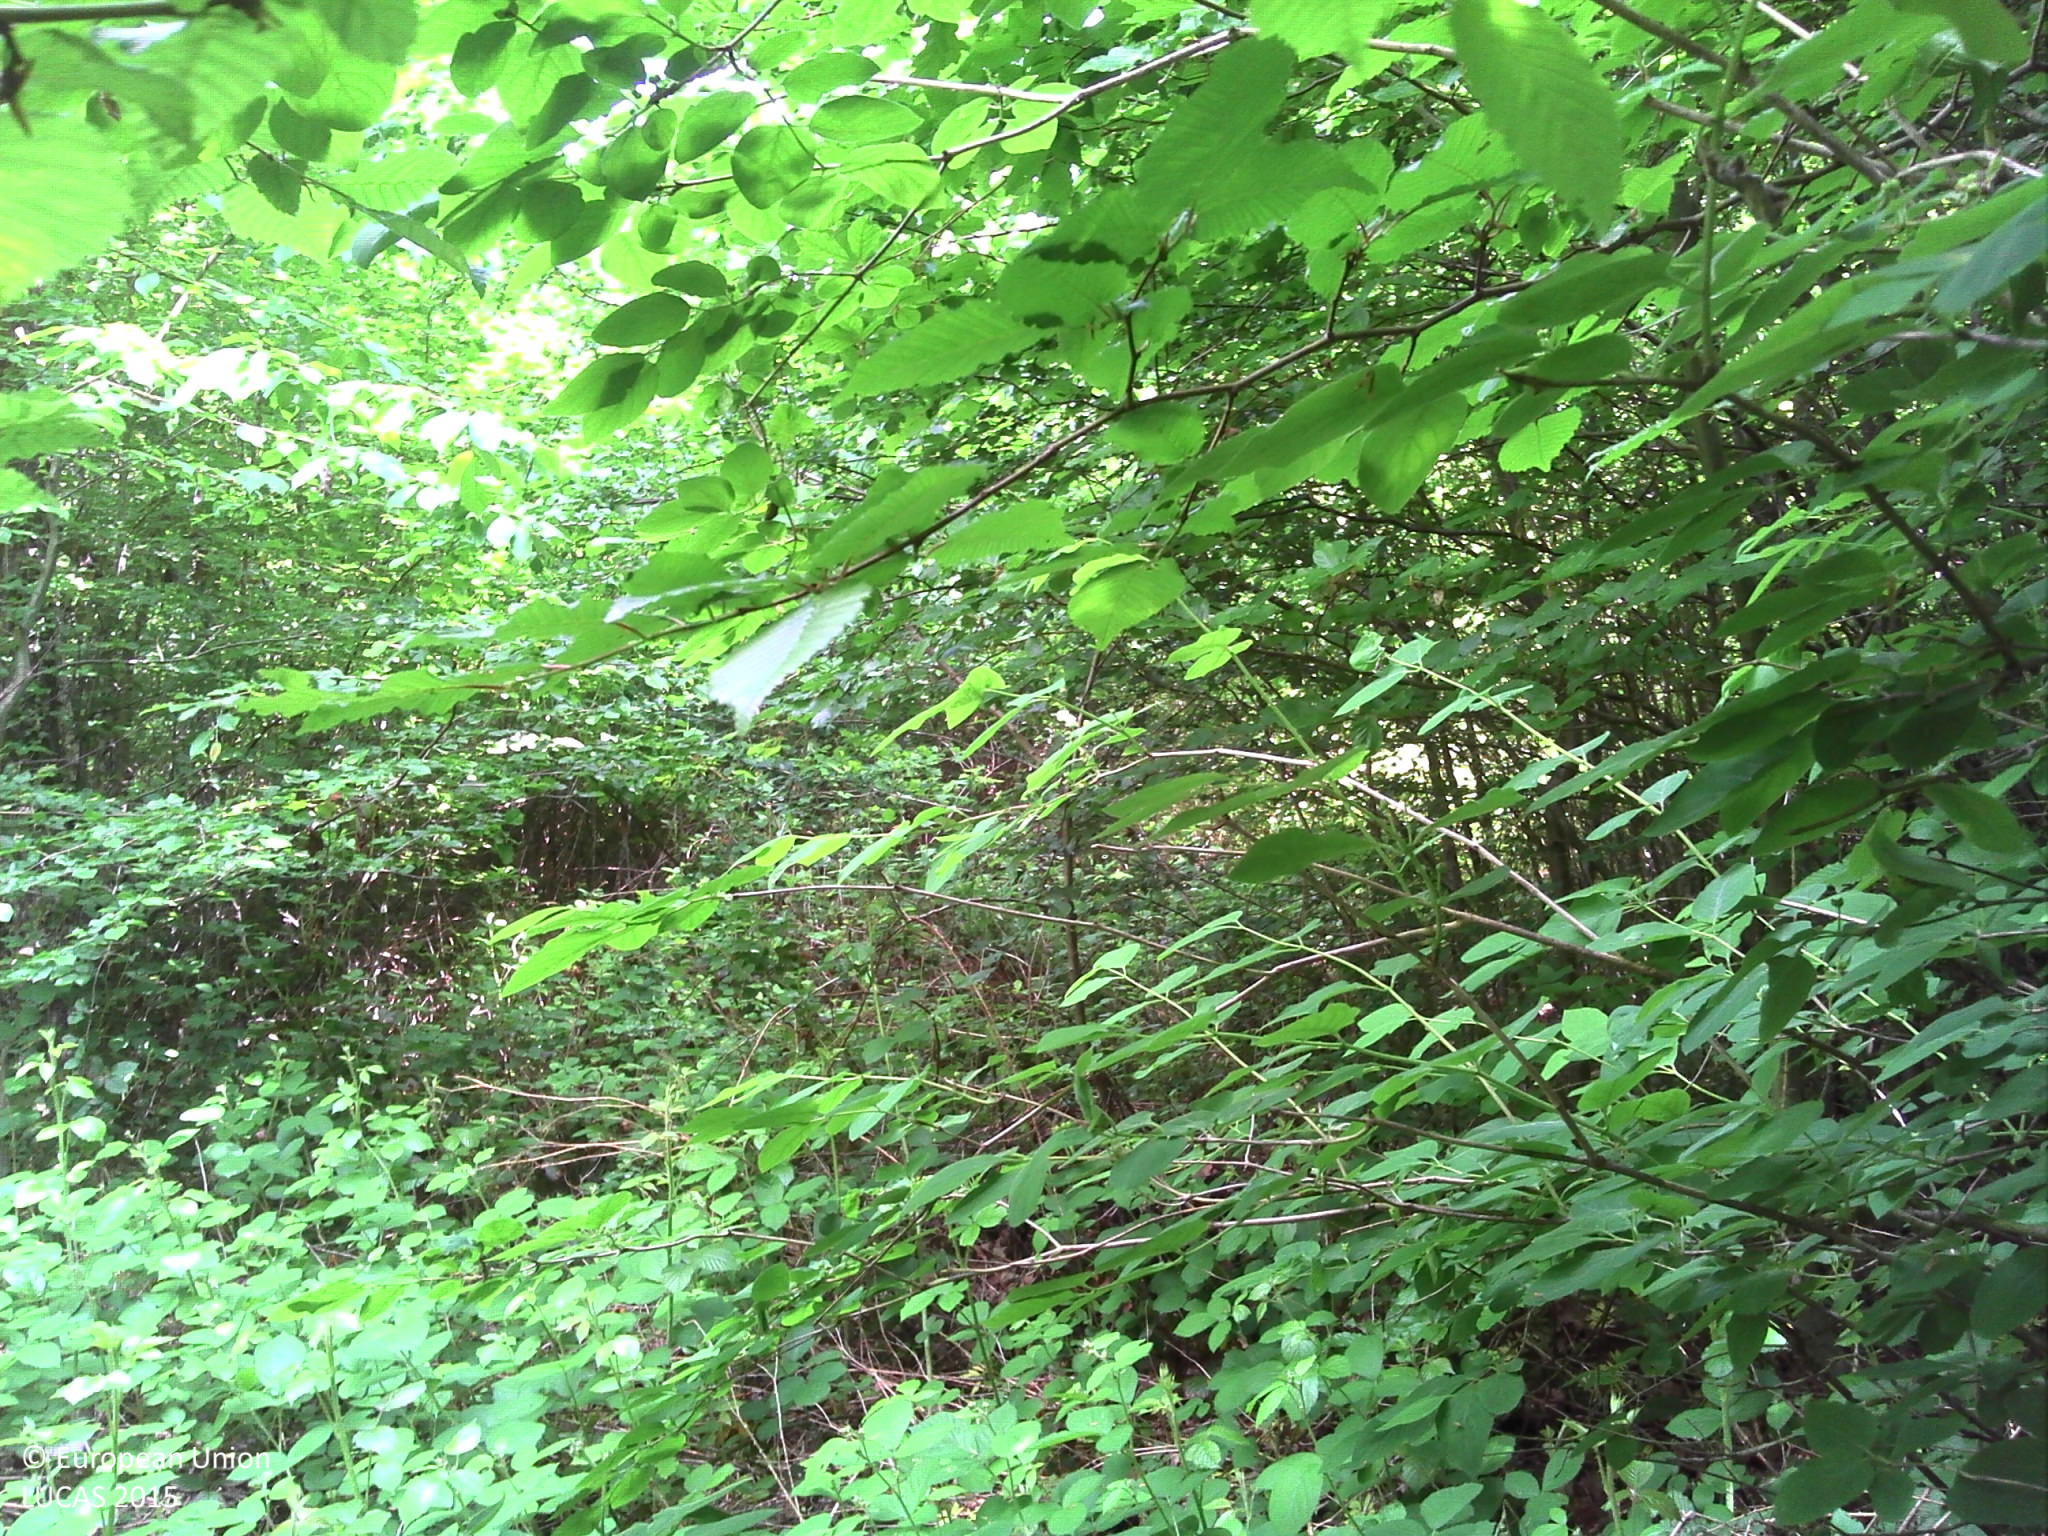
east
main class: Woodland
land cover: Broadleaved woodland
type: mesophytic deciduous forest
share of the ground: > 75 %
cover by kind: broadleaved forest trees 90 %, herbaceous plants 5 %, lichens and mosses 5 %
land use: Forestry
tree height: > 5 m
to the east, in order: Broadleaved woodland; Tracks; Broadleaved woodland; Tracks; Broadleaved woodland
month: May
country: FR
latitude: 47.7888
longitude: 4.3250
